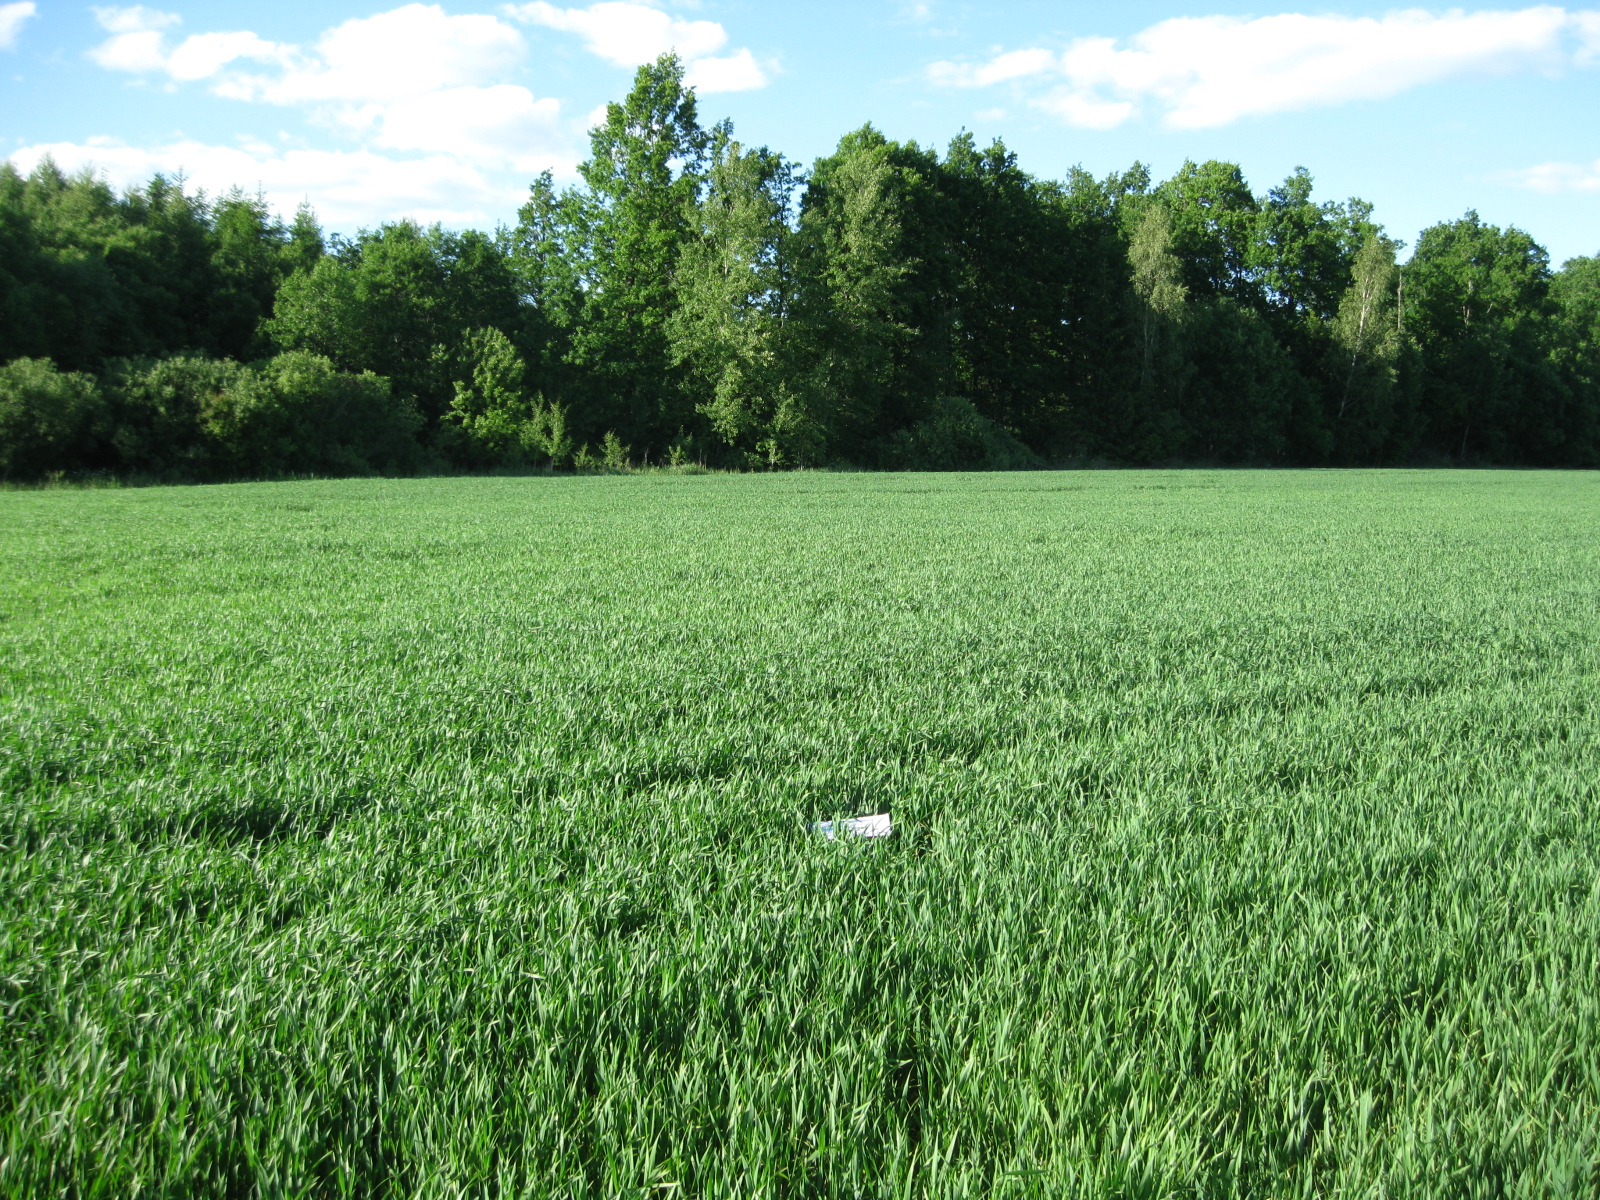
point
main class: Cropland
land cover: Common wheat
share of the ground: > 75 %
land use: Agriculture (excluding fallow land and kitchen gardens)
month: June
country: LT
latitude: 55.3465
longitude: 23.6279
